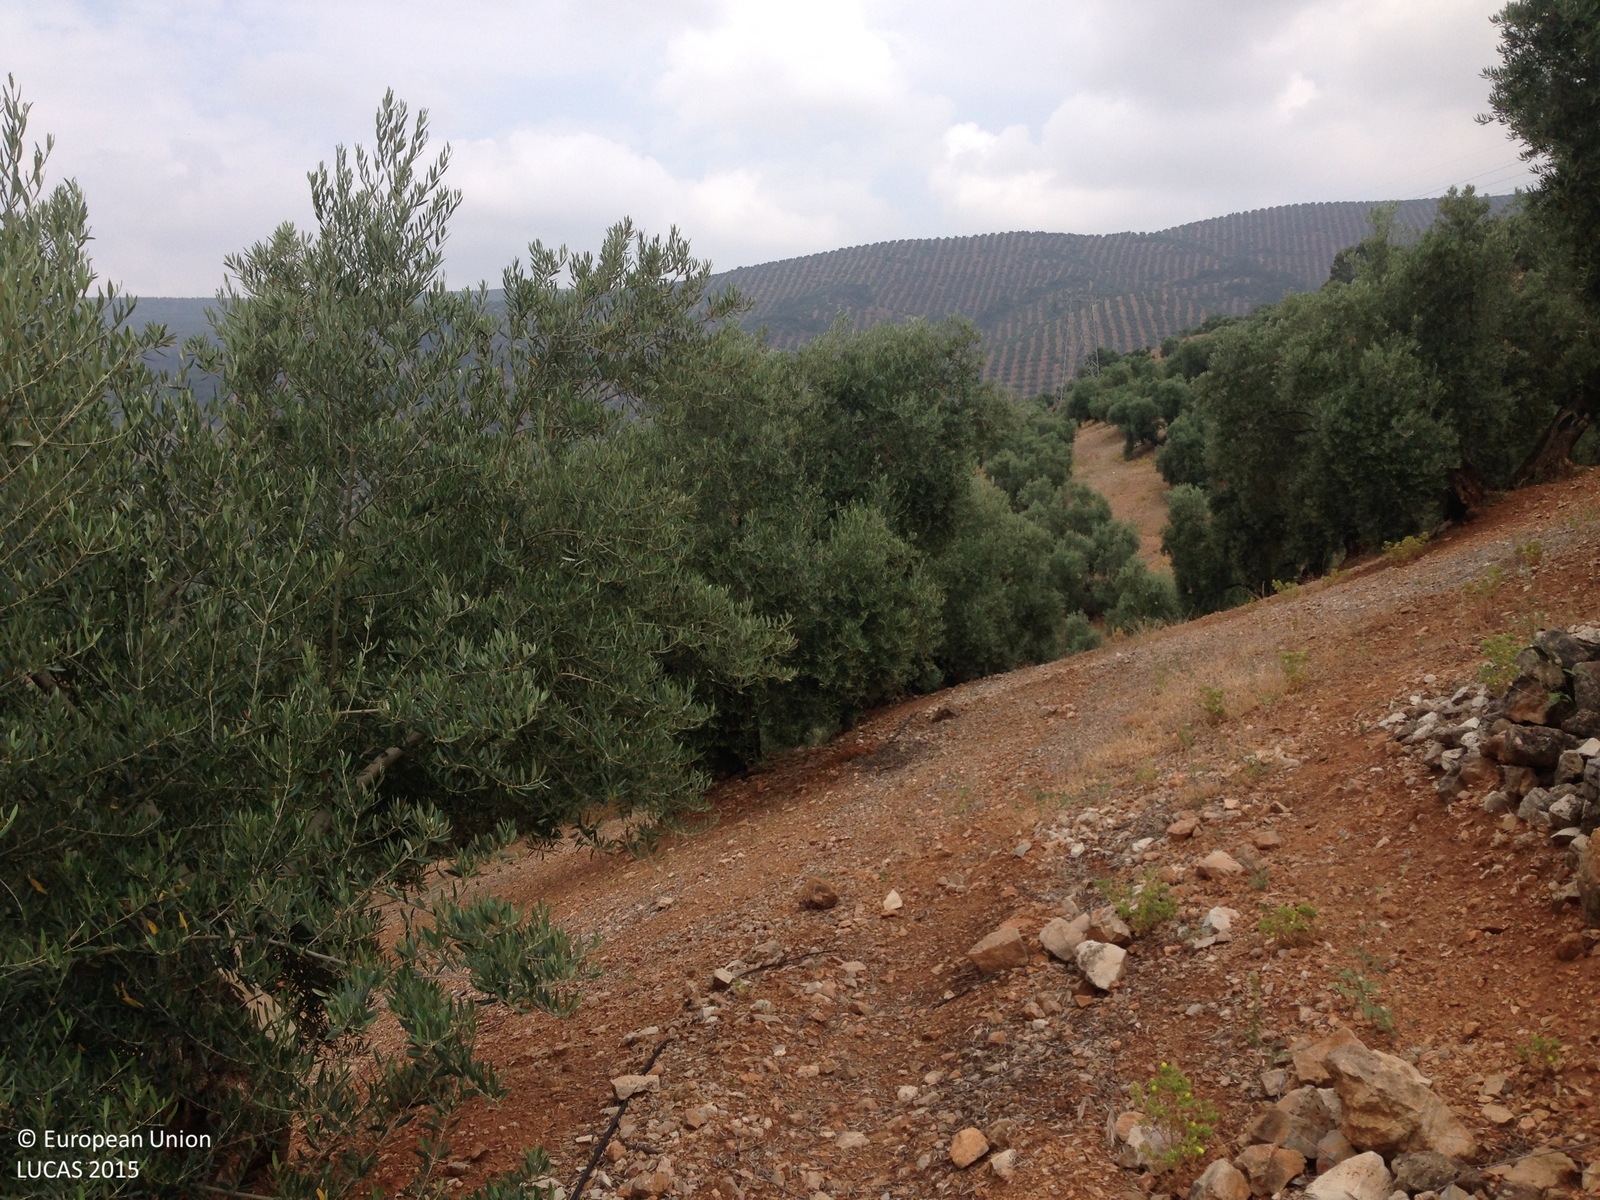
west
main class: Cropland
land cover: Olive groves
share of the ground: 25 - 50 %
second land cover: Other bare soil
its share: > 75 %
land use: Agriculture (excluding fallow land and kitchen gardens)
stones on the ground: > 50 %
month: June
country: ES
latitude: 38.1805
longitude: -2.9327
